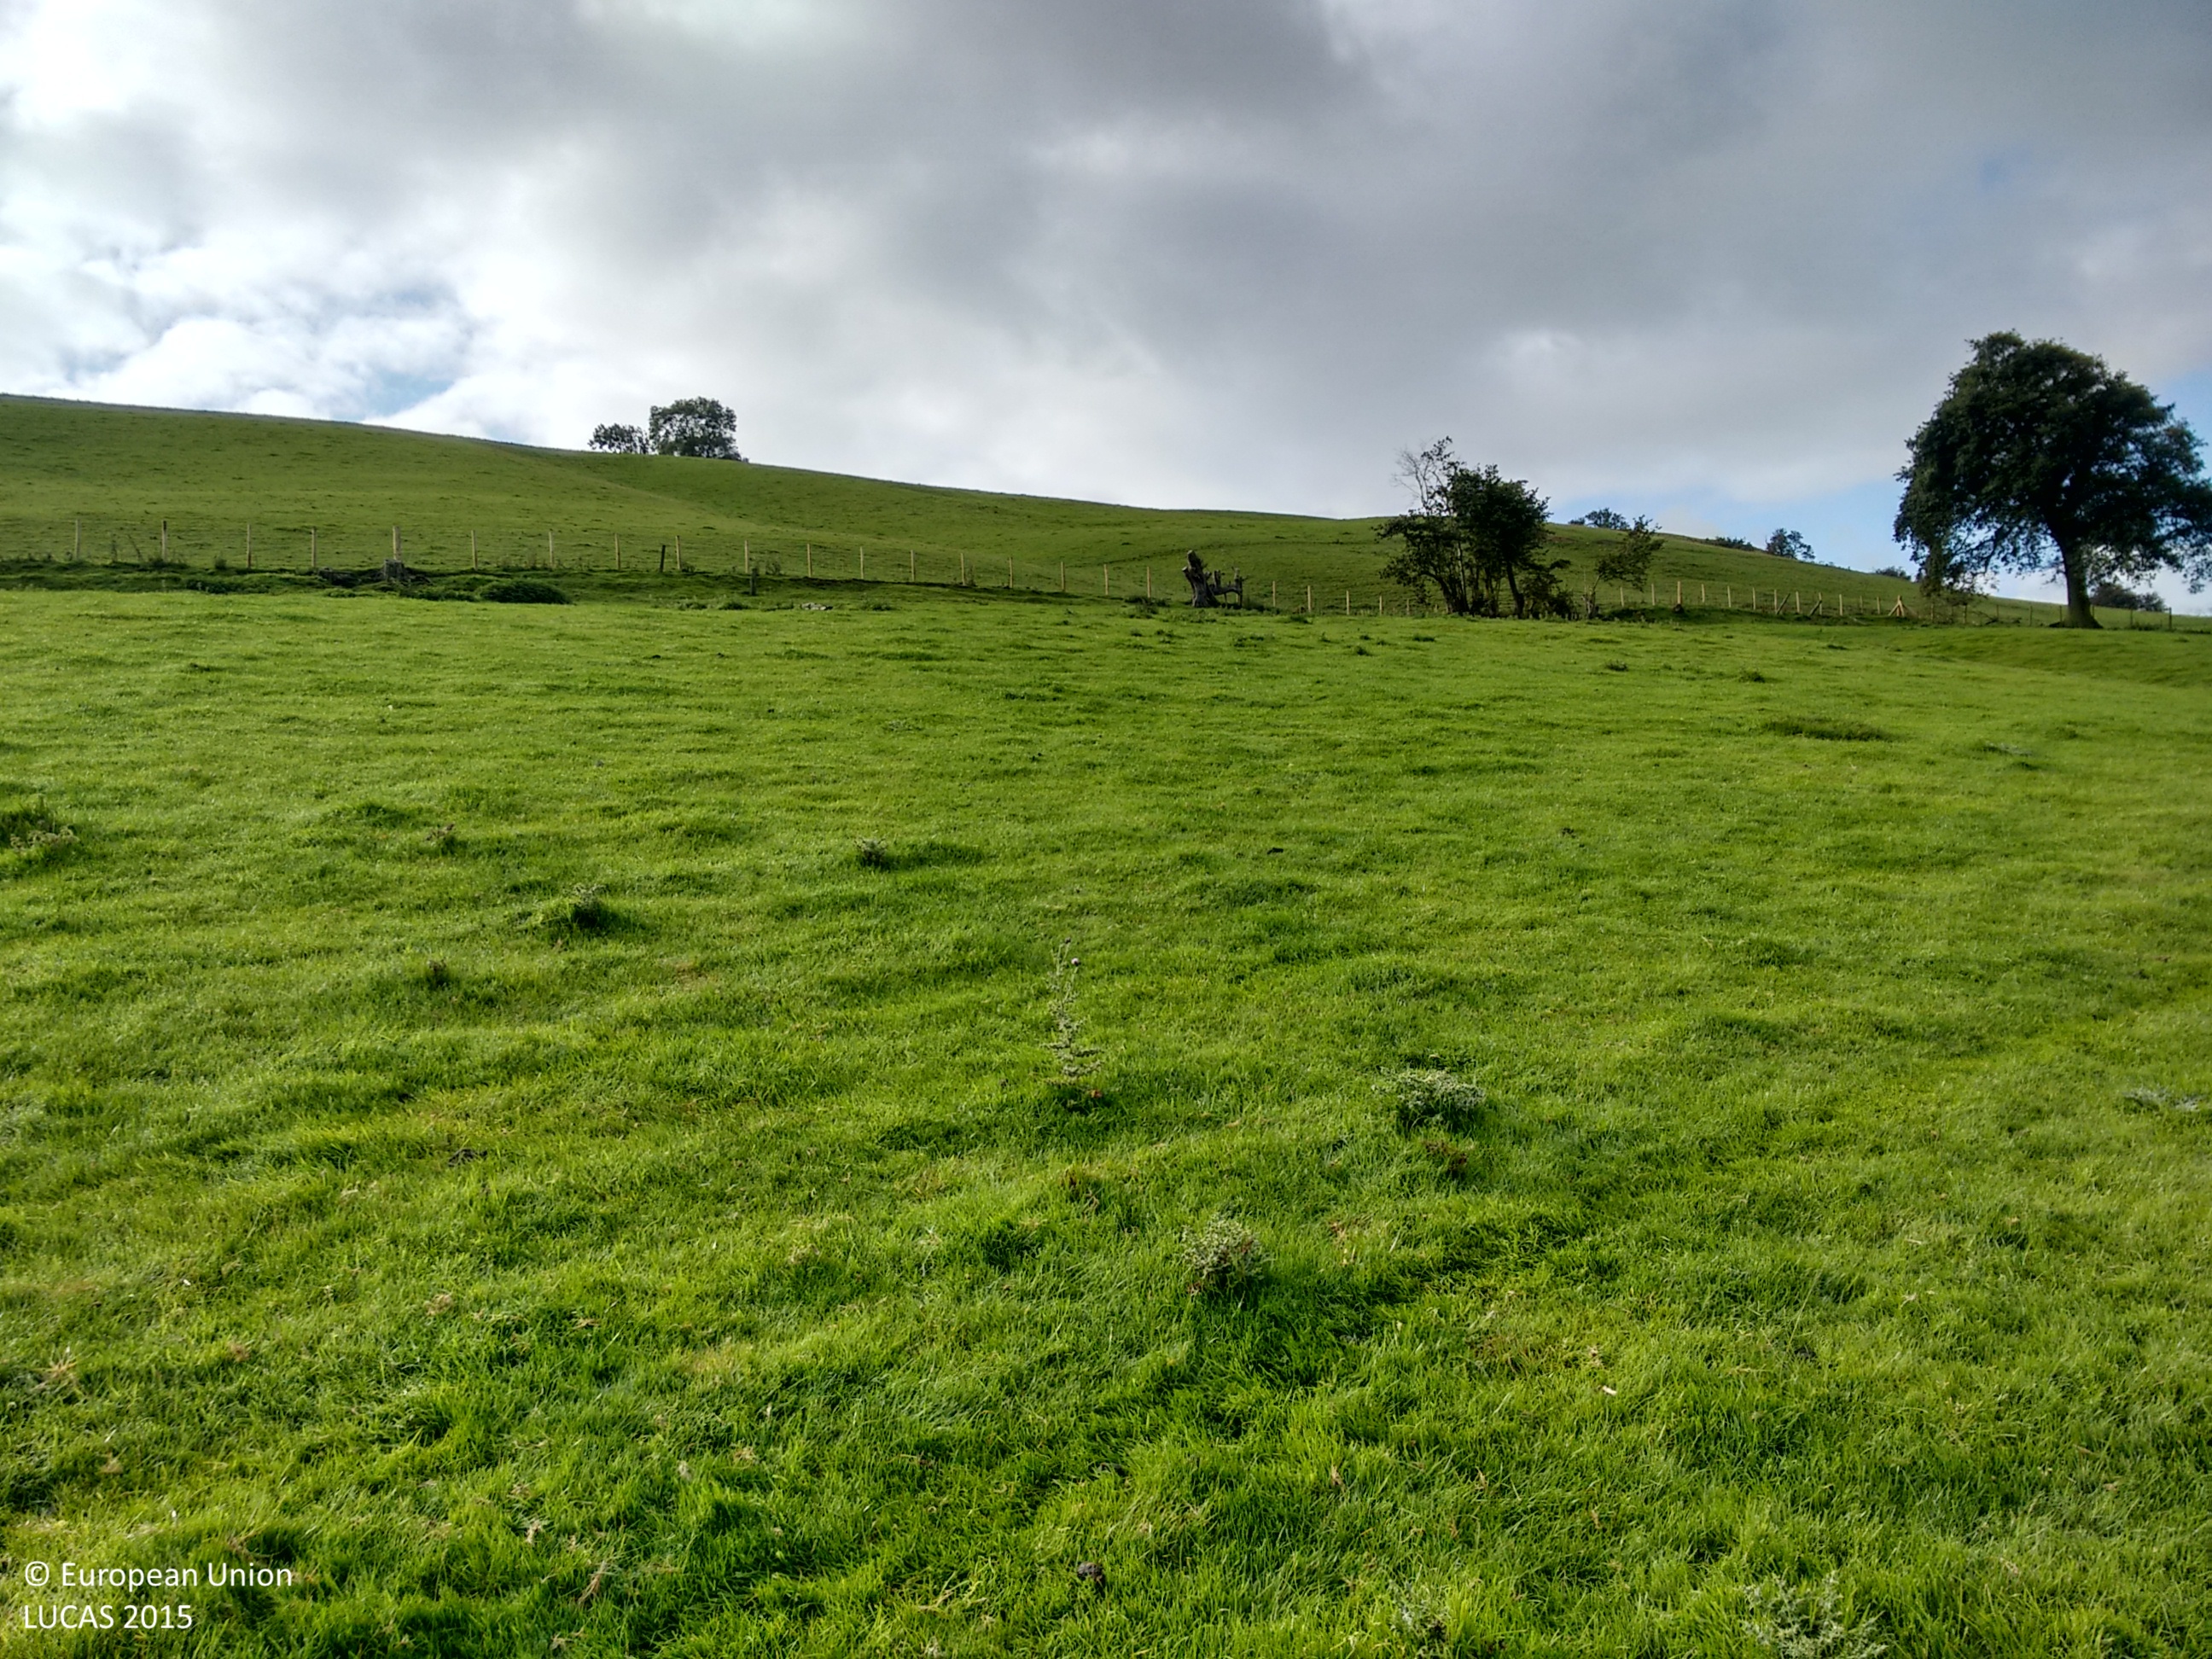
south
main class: Grassland
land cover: Grassland without tree/shrub cover
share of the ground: > 75 %
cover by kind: herbaceous plants 100 %
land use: Agriculture (excluding fallow land and kitchen gardens)
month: September
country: GB
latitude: 52.6096
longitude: -3.2974
